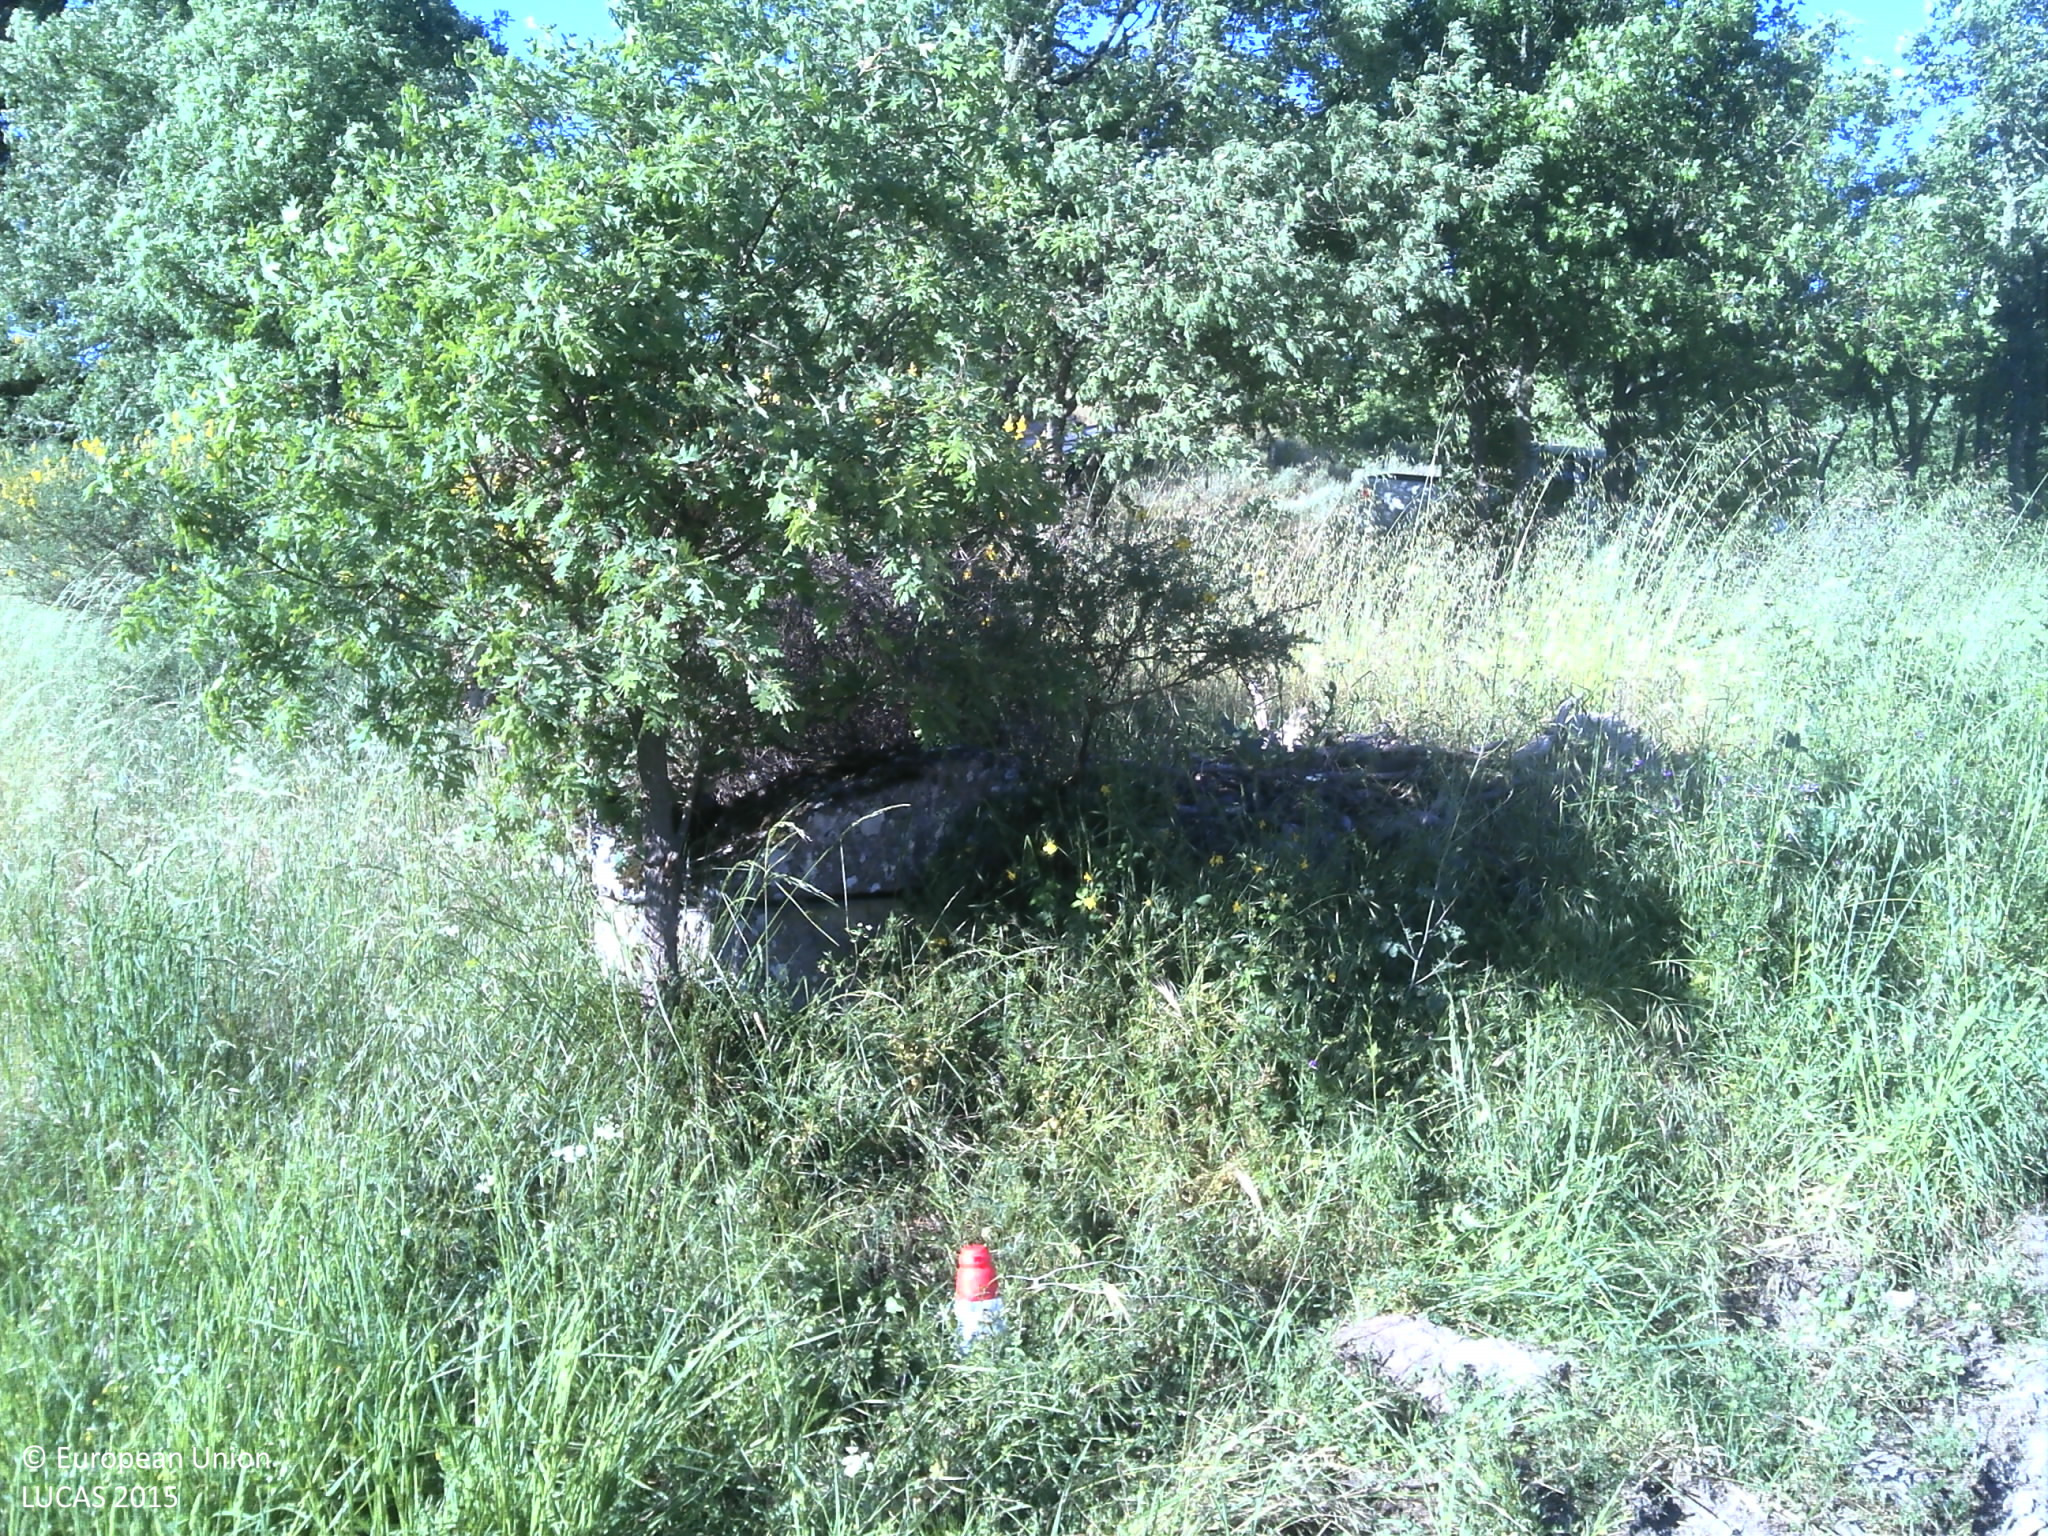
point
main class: Grassland
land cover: Grassland with sparse tree/shrub cover
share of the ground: 25 - 50 %
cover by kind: herbaceous plants 65 %, unconsolidated bare surface 25 %, broadleaved forest trees 5 %, shrubs 5 %
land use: Agriculture (excluding fallow land and kitchen gardens)
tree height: < 5 m
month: May
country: PT
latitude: 40.6448
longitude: -7.1448
